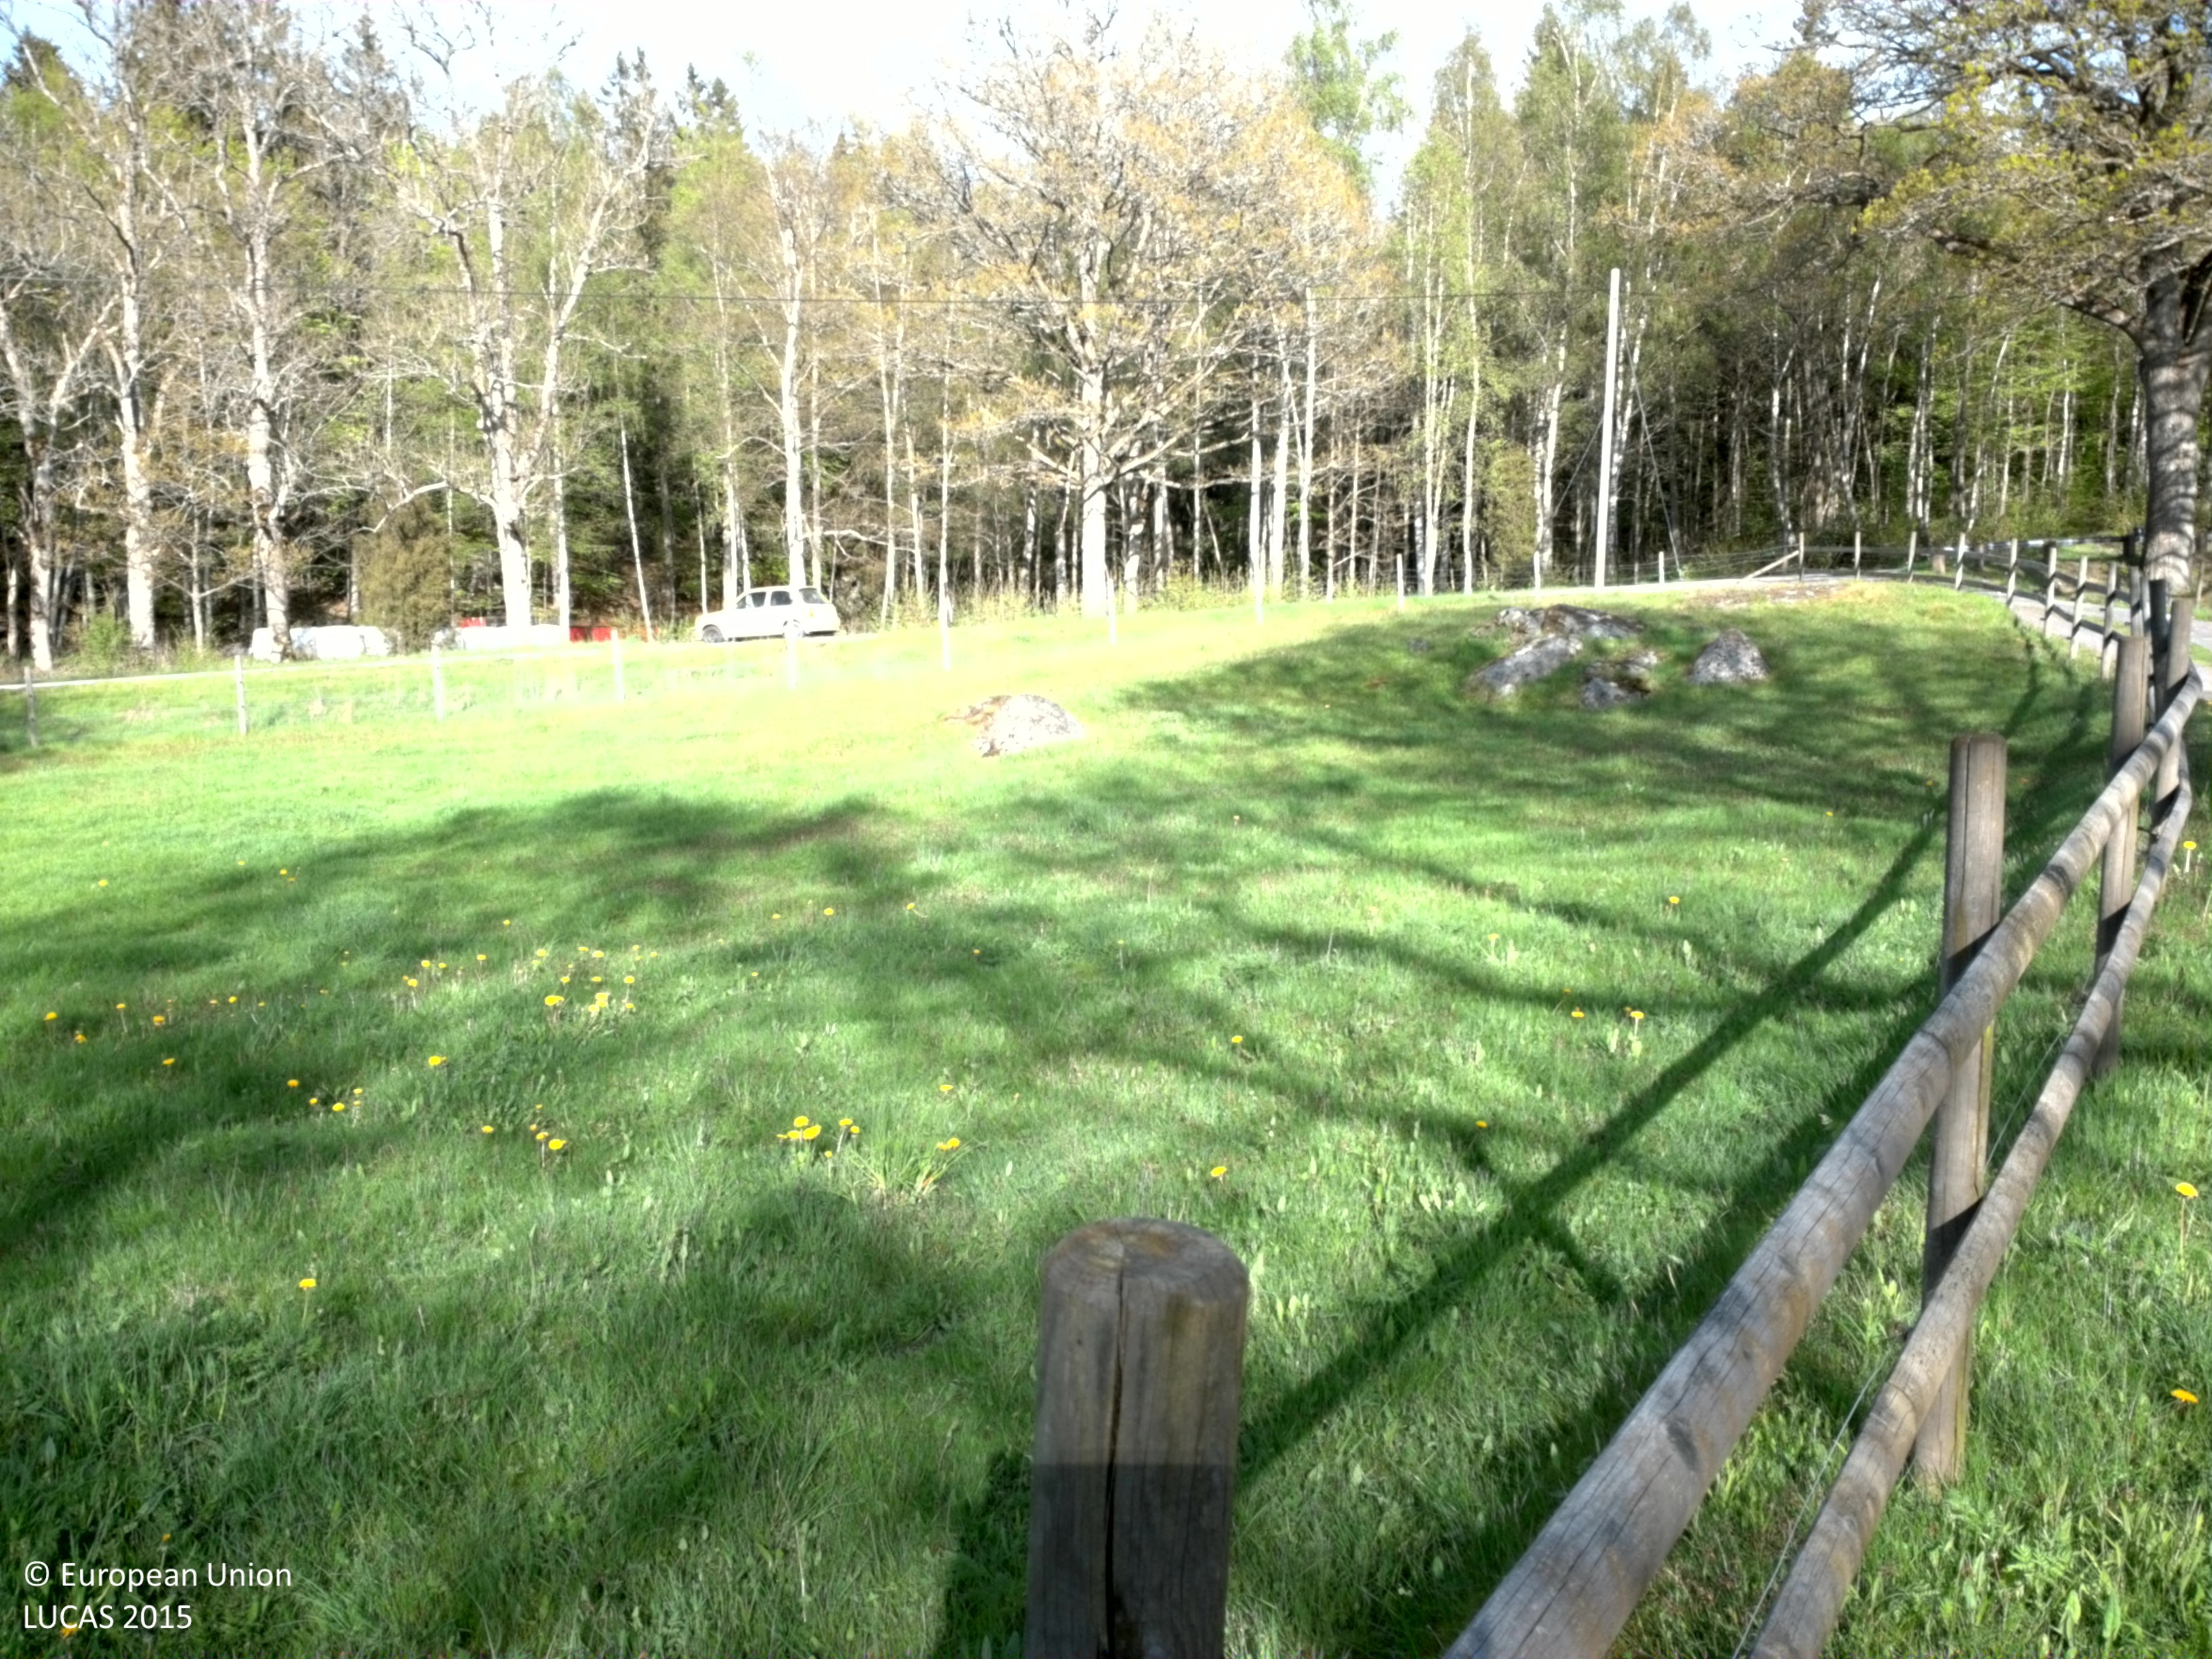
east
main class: Grassland
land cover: Grassland without tree/shrub cover
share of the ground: > 75 %
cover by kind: herbaceous plants 100 %
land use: Agriculture (excluding fallow land and kitchen gardens)
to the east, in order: Grassland without tree/shrub cover; Electric lines; Fences; Grassland without tree/shrub cover; Paved roads, cycling and walking lanes; Grass margins; Broadleaved woodland; Spruce dominated coniferous woodland
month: May
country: SE
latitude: 56.4028
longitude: 15.2975
